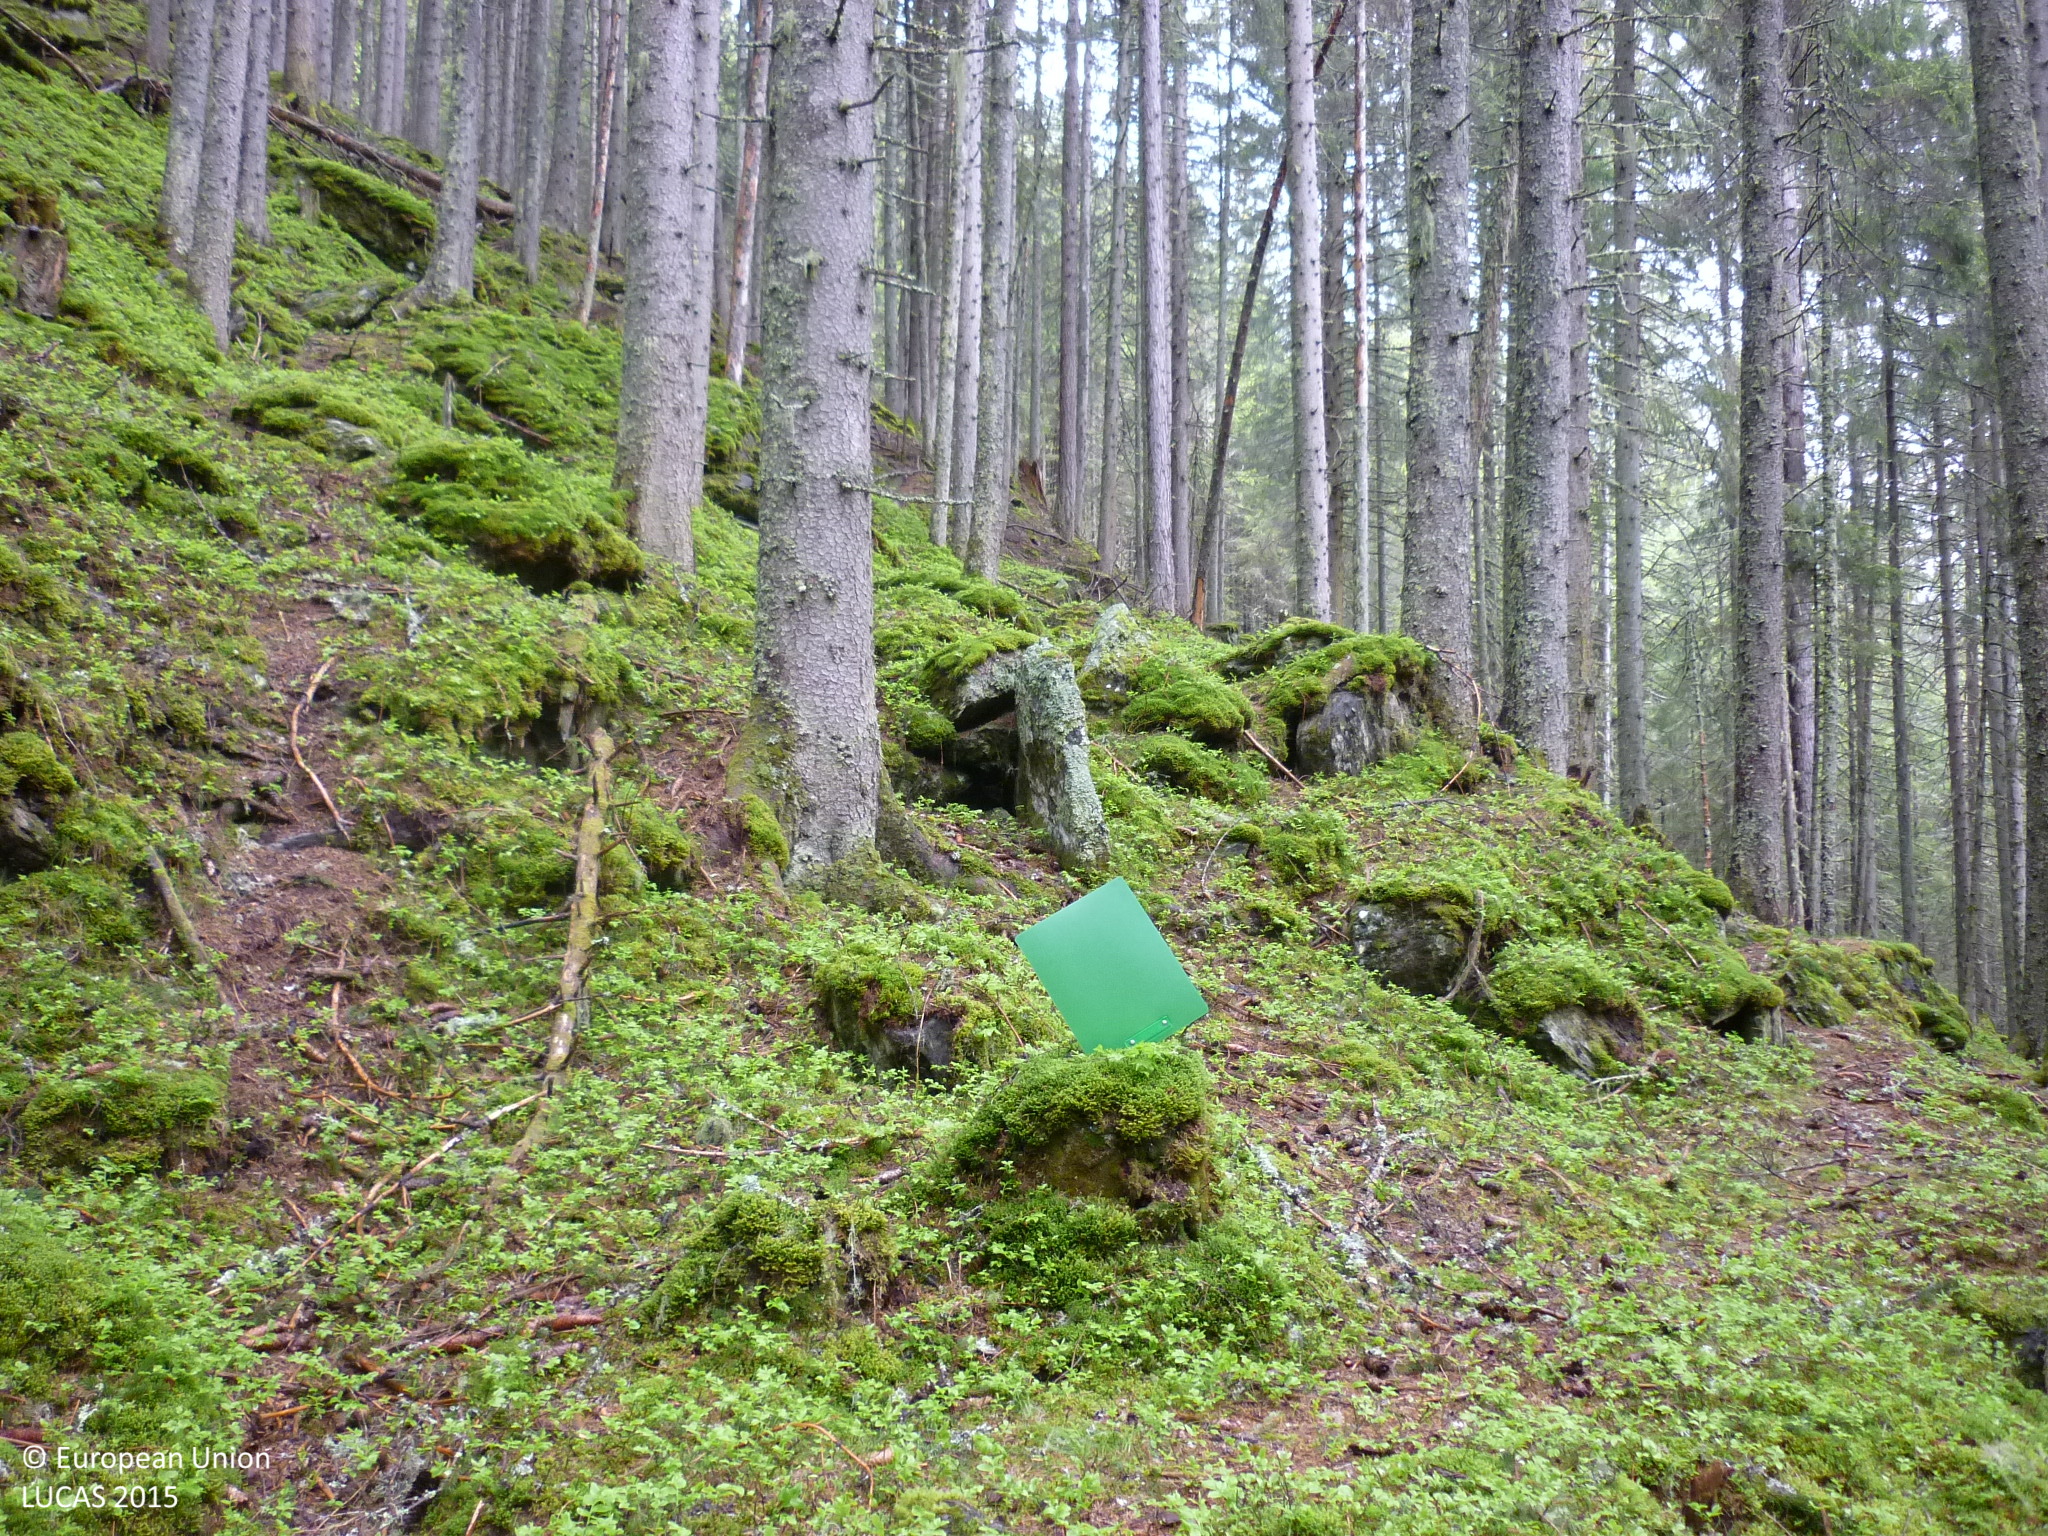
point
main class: Woodland
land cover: Spruce dominated coniferous woodland
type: alpine coniferous forest
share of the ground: > 75 %
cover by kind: coniferous forest trees 90 %, herbaceous plants 5 %, lichens and mosses 5 %
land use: Forestry
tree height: > 5 m
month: May
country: AT
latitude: 47.4077
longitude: 14.1200
